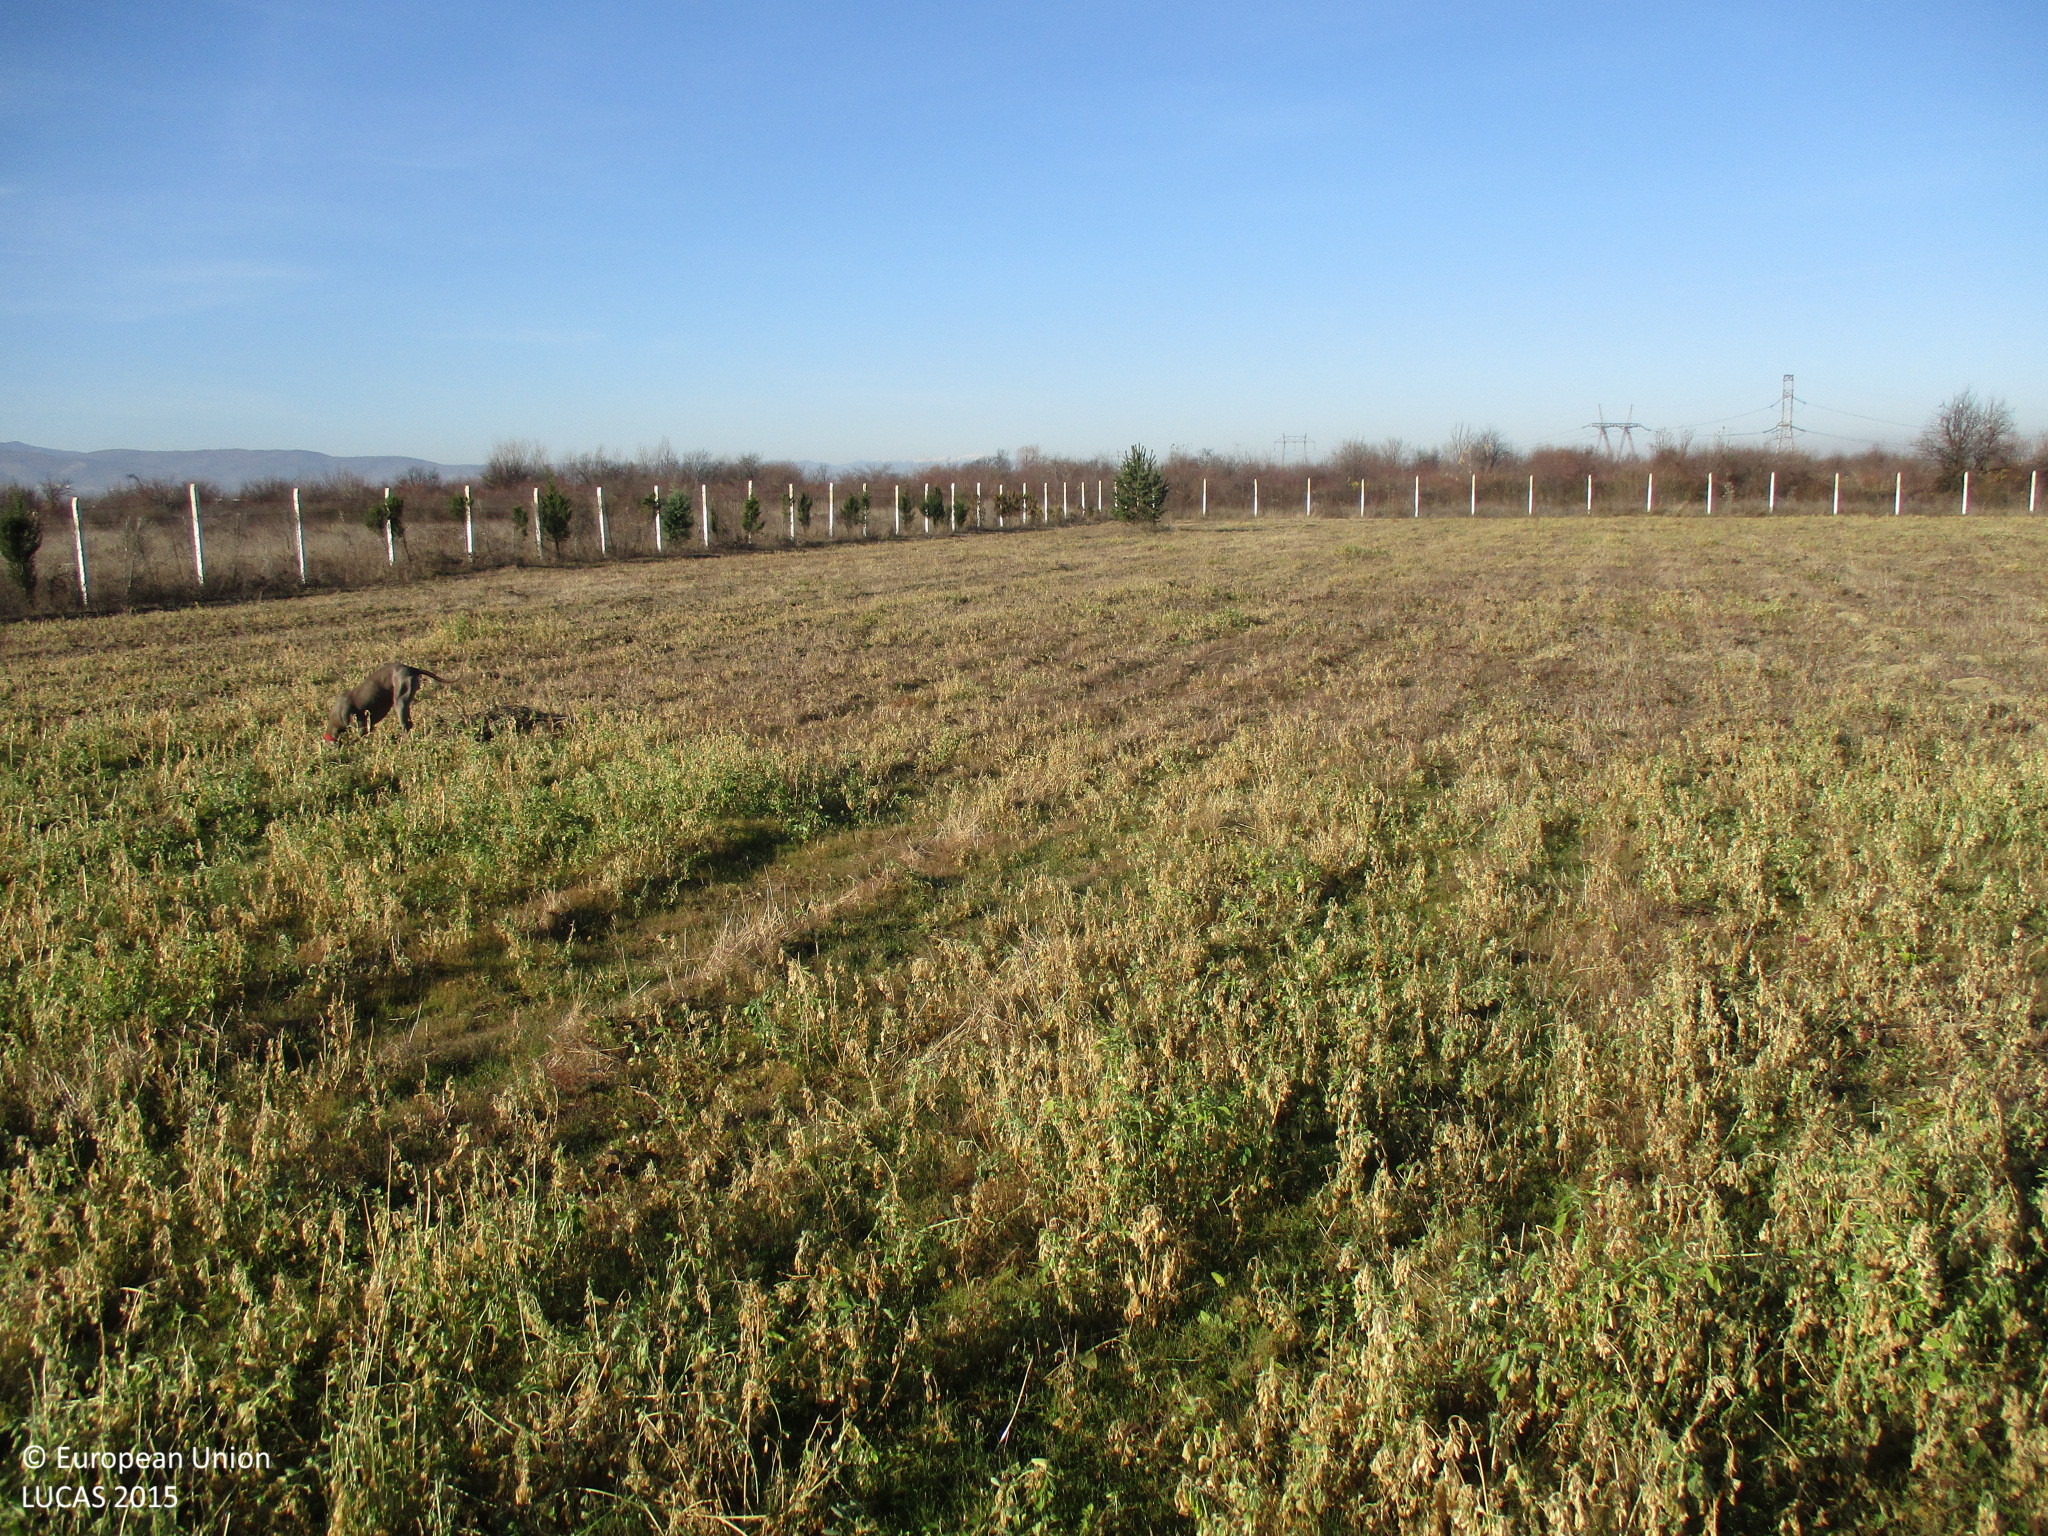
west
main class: Cropland
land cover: Lucerne
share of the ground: 50 - 75 %
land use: Agriculture (excluding fallow land and kitchen gardens)
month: December
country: BG
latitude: 42.0930
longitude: 24.7898
